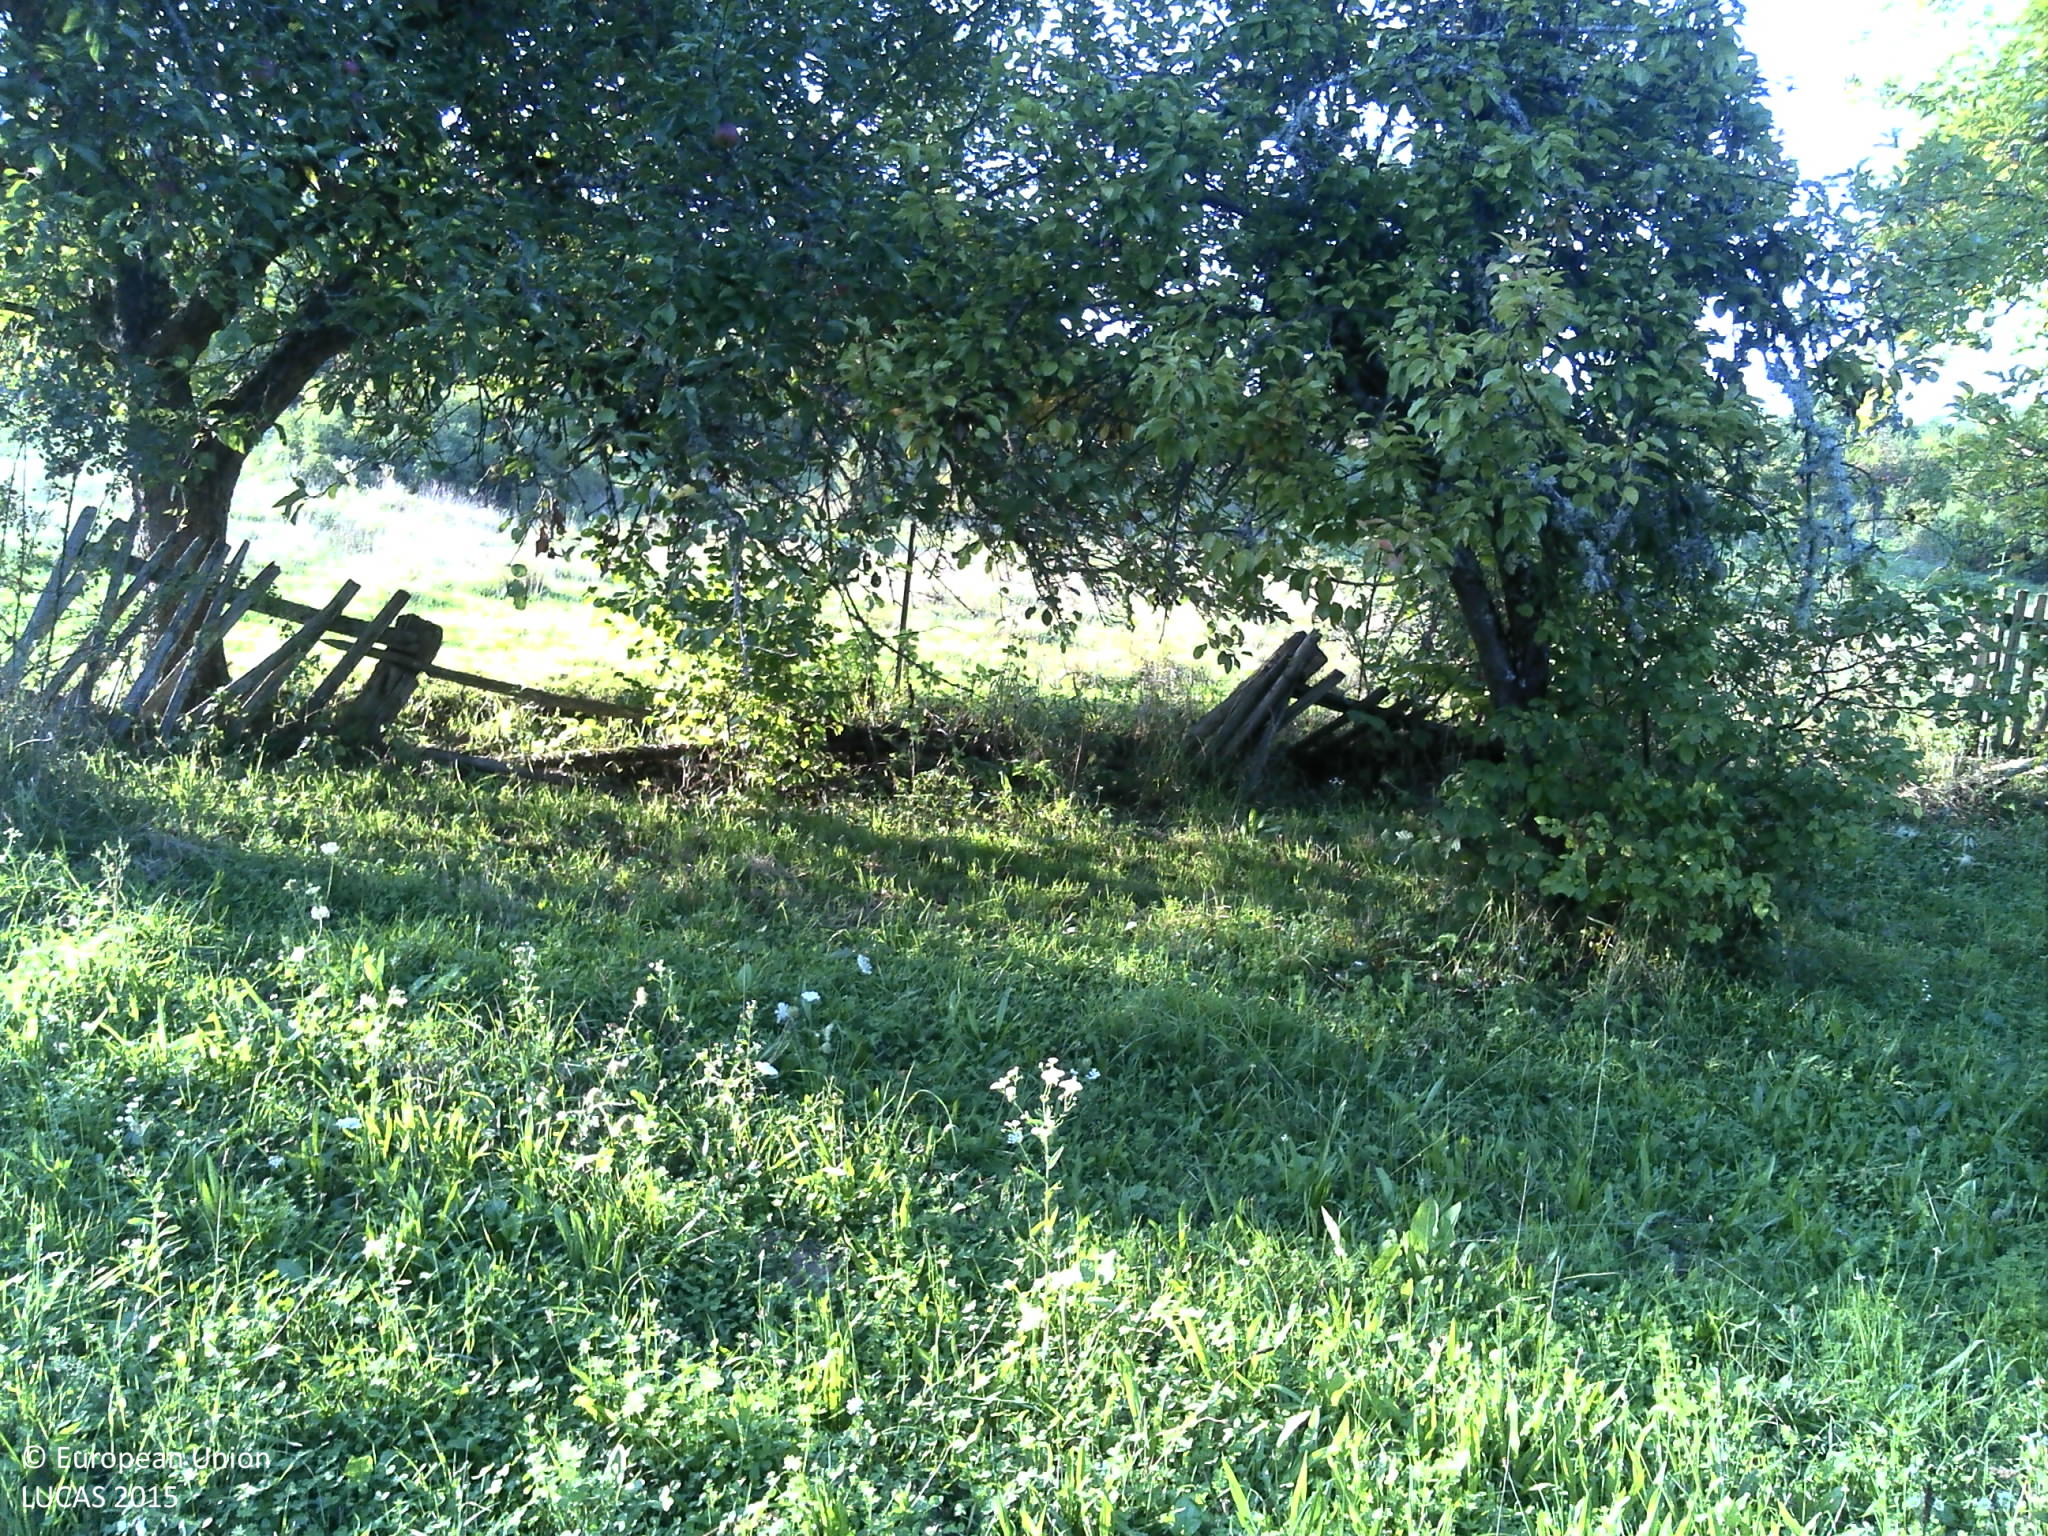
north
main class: Grassland
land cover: Spontaneously vegetated surfaces
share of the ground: > 75 %
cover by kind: herbaceous plants 100 %
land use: Semi-natural and natural areas not in use
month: August
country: HR
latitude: 45.1360
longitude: 16.2909
